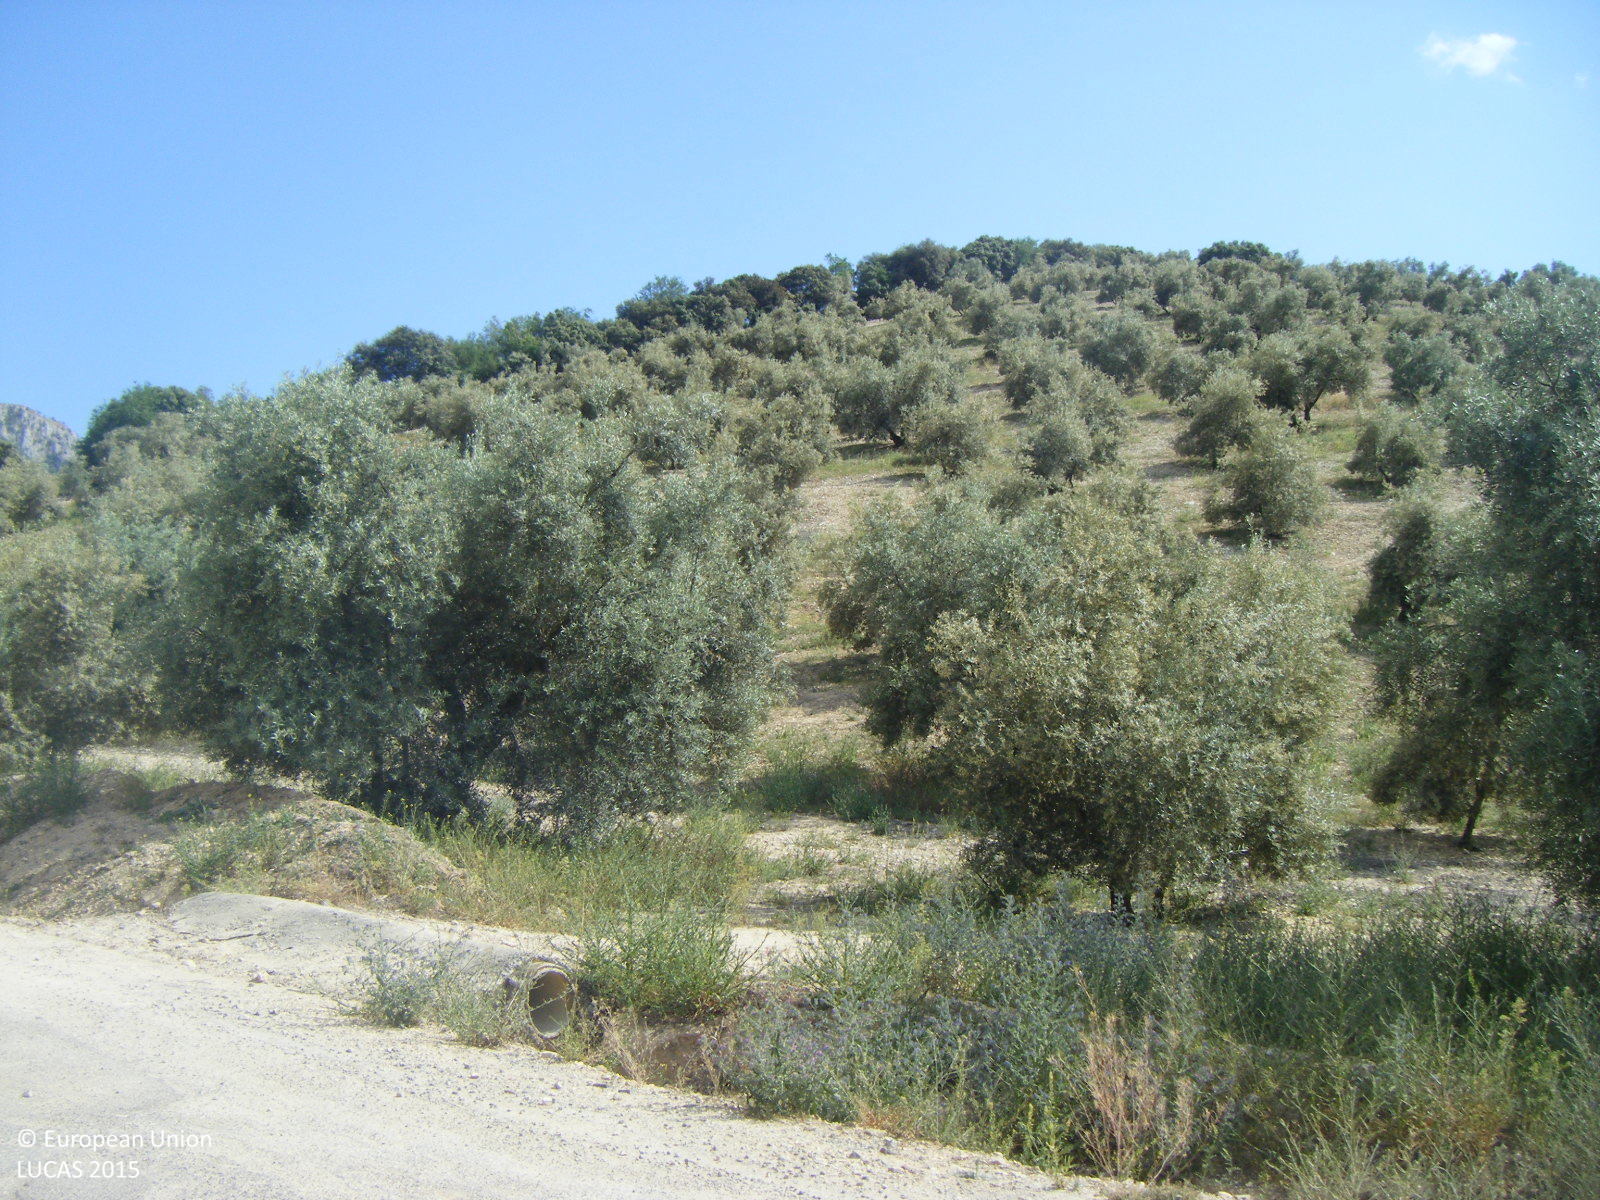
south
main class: Cropland
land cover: Olive groves
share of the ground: 10 - 25 %
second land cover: Other bare soil
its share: > 75 %
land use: Agriculture (excluding fallow land and kitchen gardens)
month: May
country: ES
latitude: 37.1246
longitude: -4.3923
